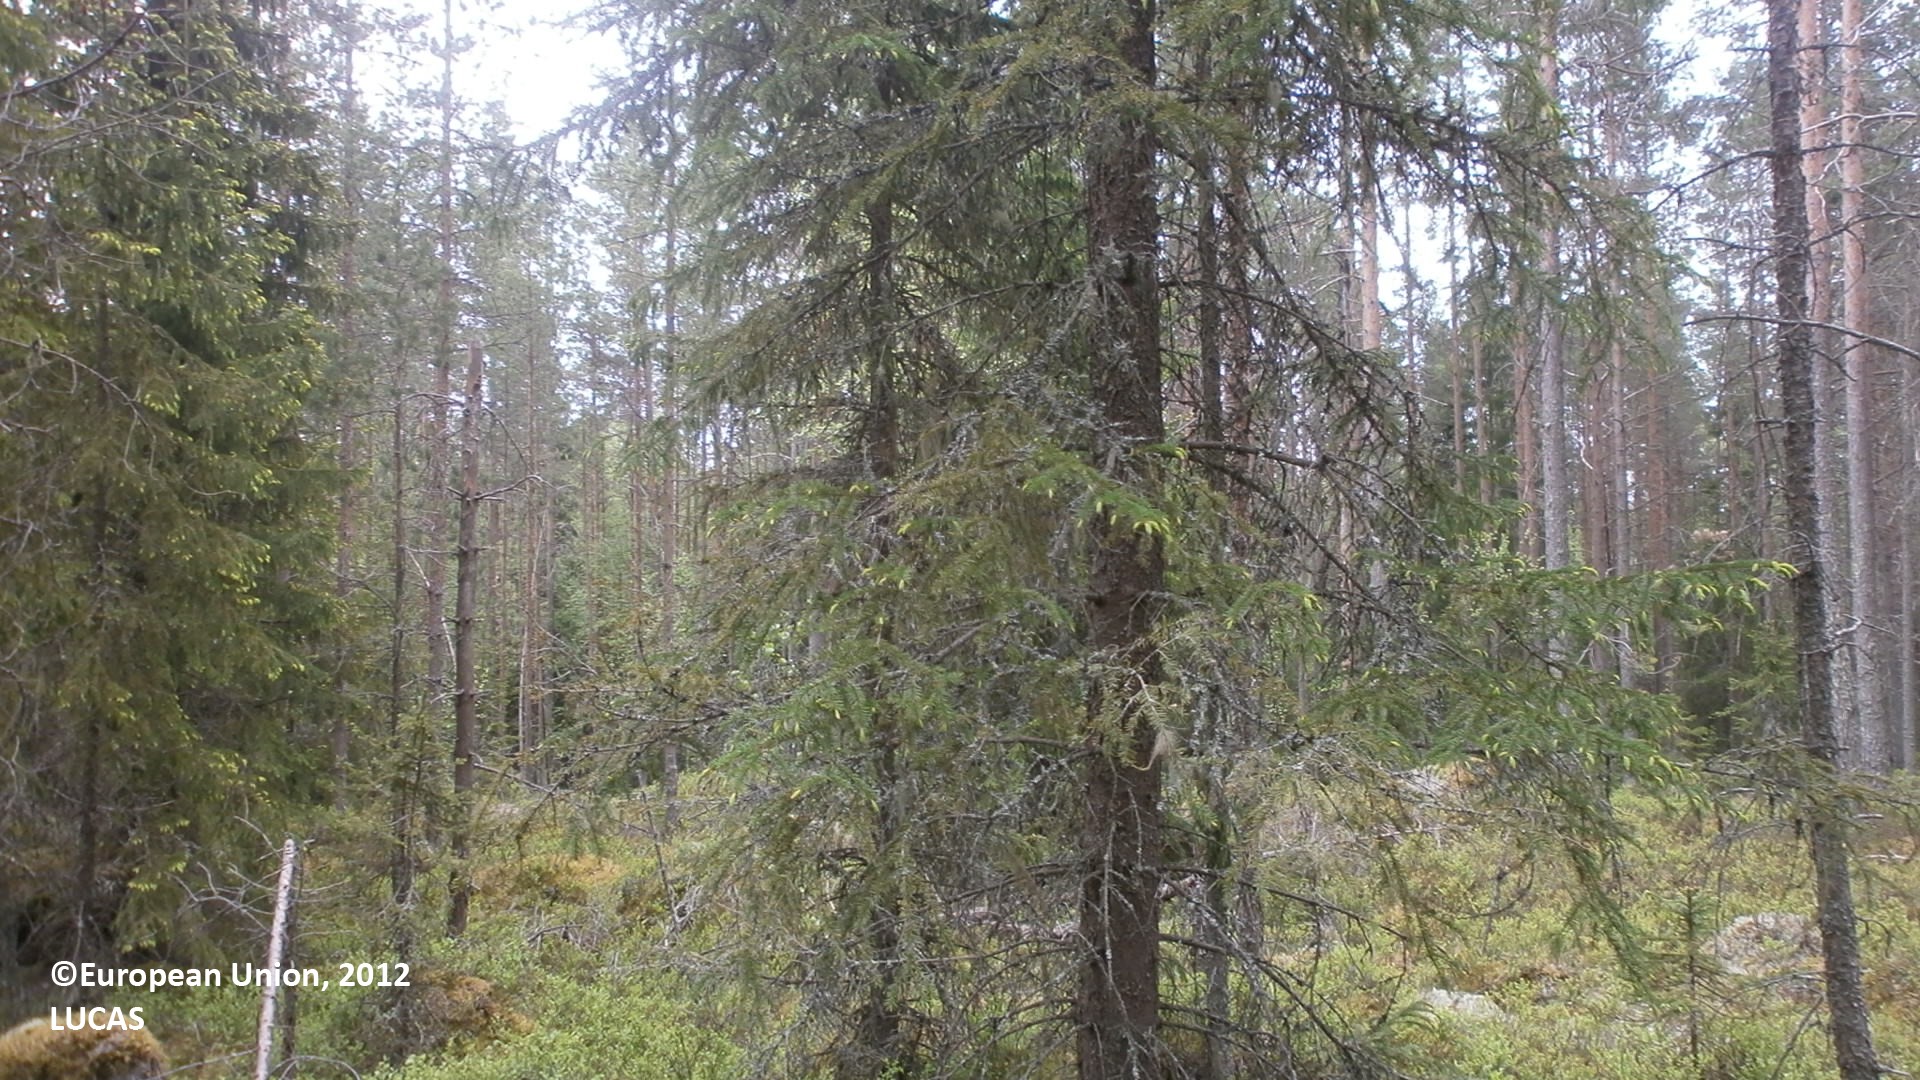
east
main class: Woodland
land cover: Pine dominated coniferous woodland
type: hemiboreal forest and nemoral coniferous forest and mixed broadleaved-coniferous forest
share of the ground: 25 - 50 %
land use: Forestry
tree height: > 5 m
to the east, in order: Pine dominated coniferous woodland; Other coniferous woodland; Other mixed woodland; Ditches and canals; Pine dominated mixed woodland; Ditches and canals; Other mixed woodland; Pine dominated coniferous woodland; Spruce dominated coniferous woodland
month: June
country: FI
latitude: 64.4410
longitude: 25.1437
